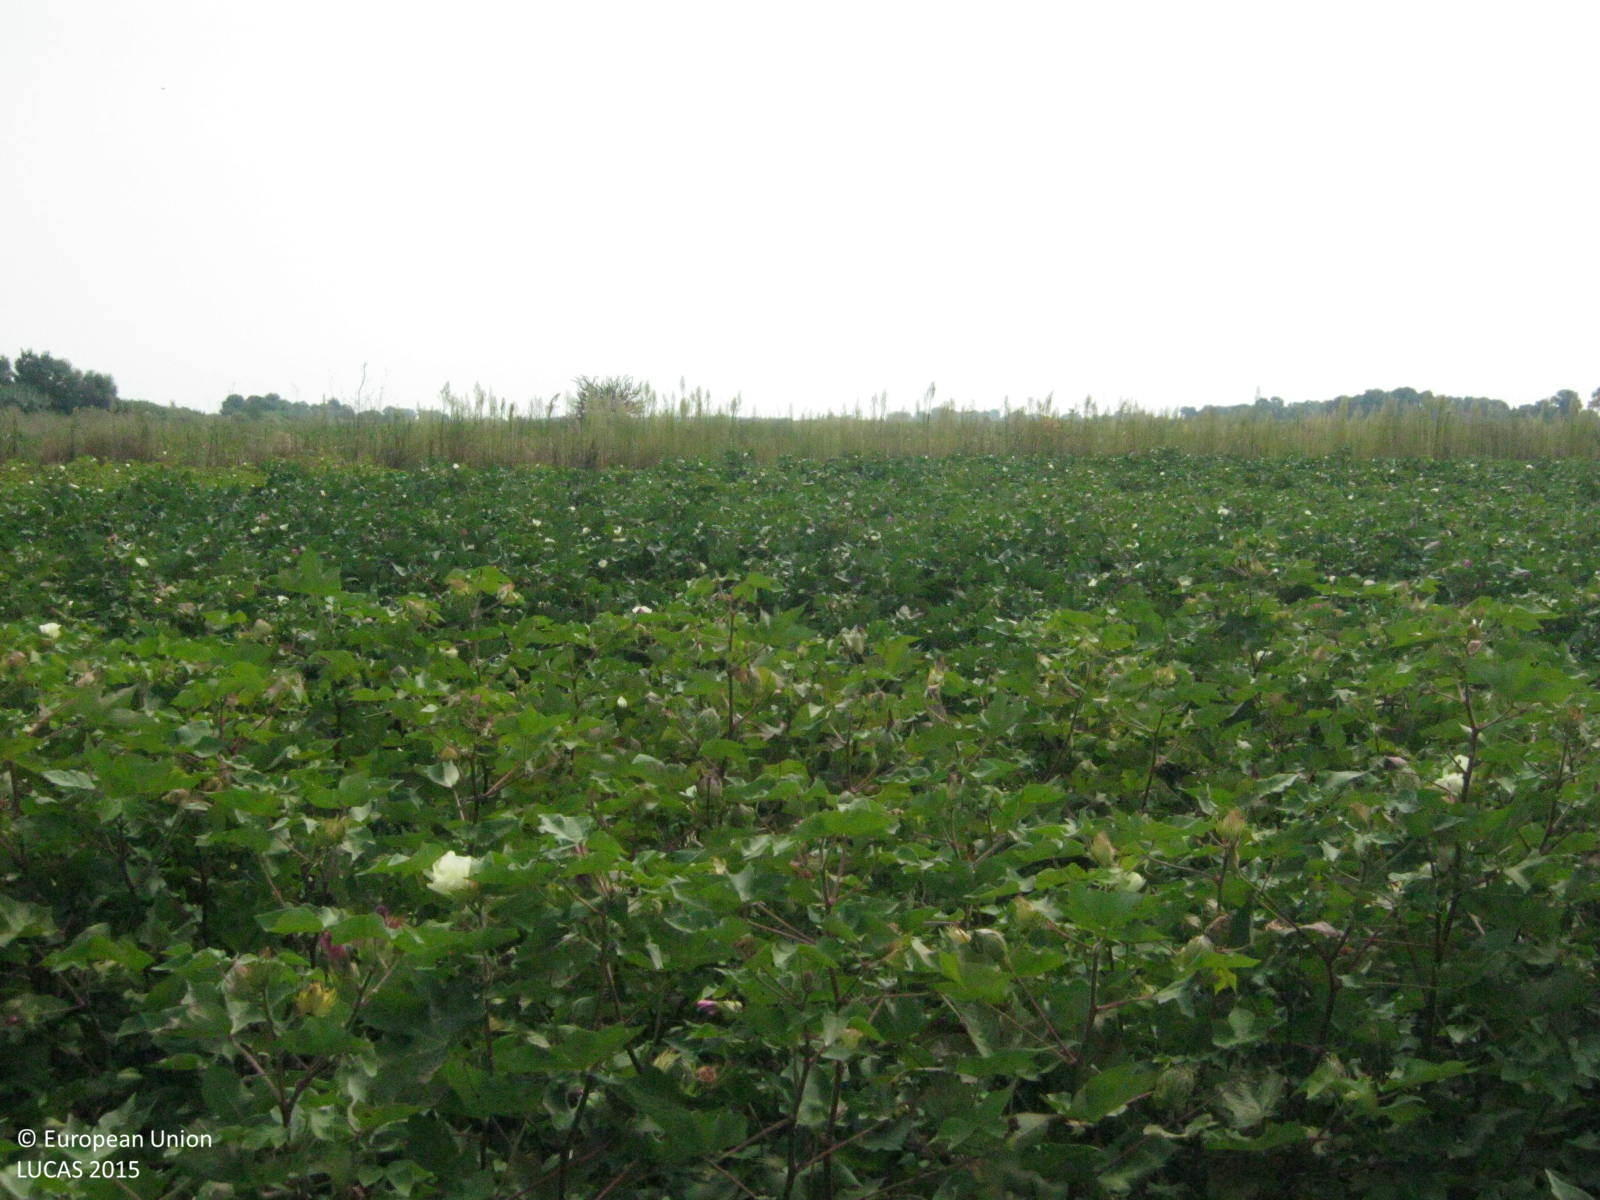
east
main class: Cropland
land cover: Cotton
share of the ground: > 75 %
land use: Agriculture (excluding fallow land and kitchen gardens)
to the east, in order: Cotton; Shruby margins; Ditches and canals; Shruby margins; Cotton; Grass margins; Tracks; Grass margins; Shrubland with sparse tree cover
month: August
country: GR
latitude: 40.5543
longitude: 22.5552
